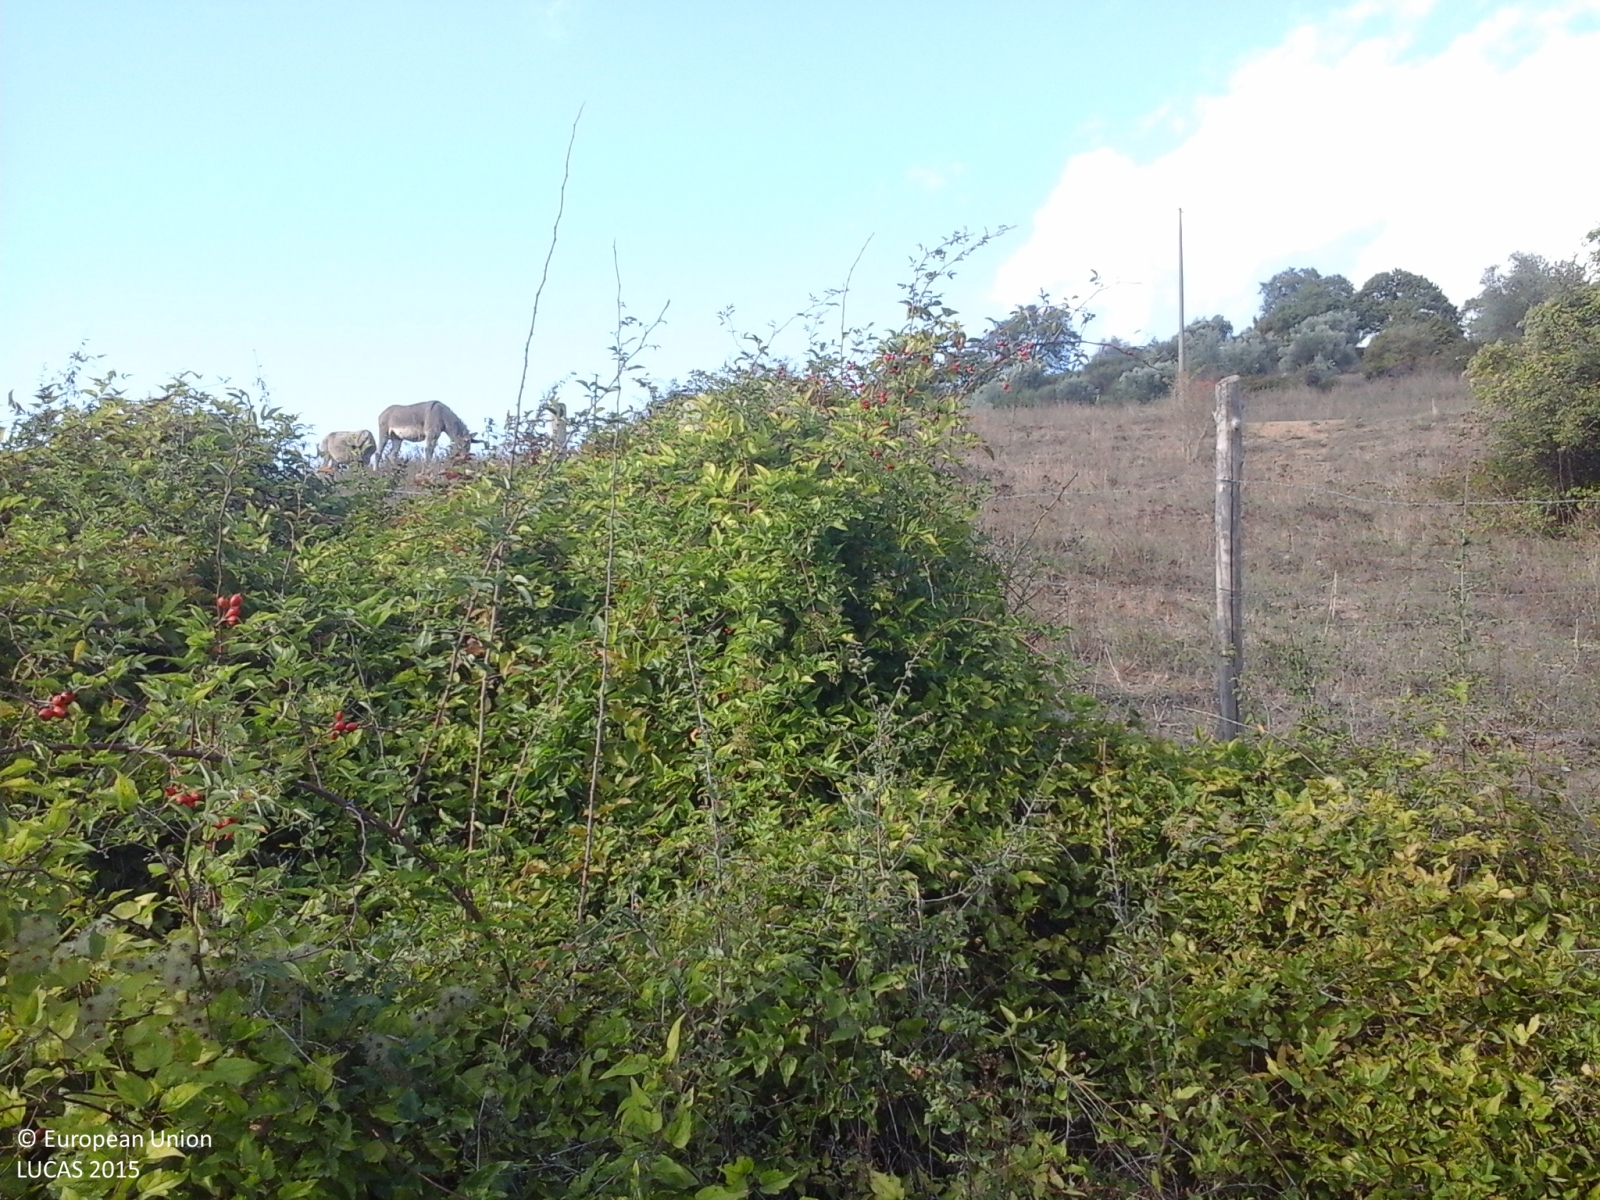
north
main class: Cropland
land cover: Olive groves
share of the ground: 25 - 50 %
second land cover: Grassland without tree/shrub cover
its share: > 75 %
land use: Agriculture (excluding fallow land and kitchen gardens)
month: October
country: IT
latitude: 43.2427
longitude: 12.2719
